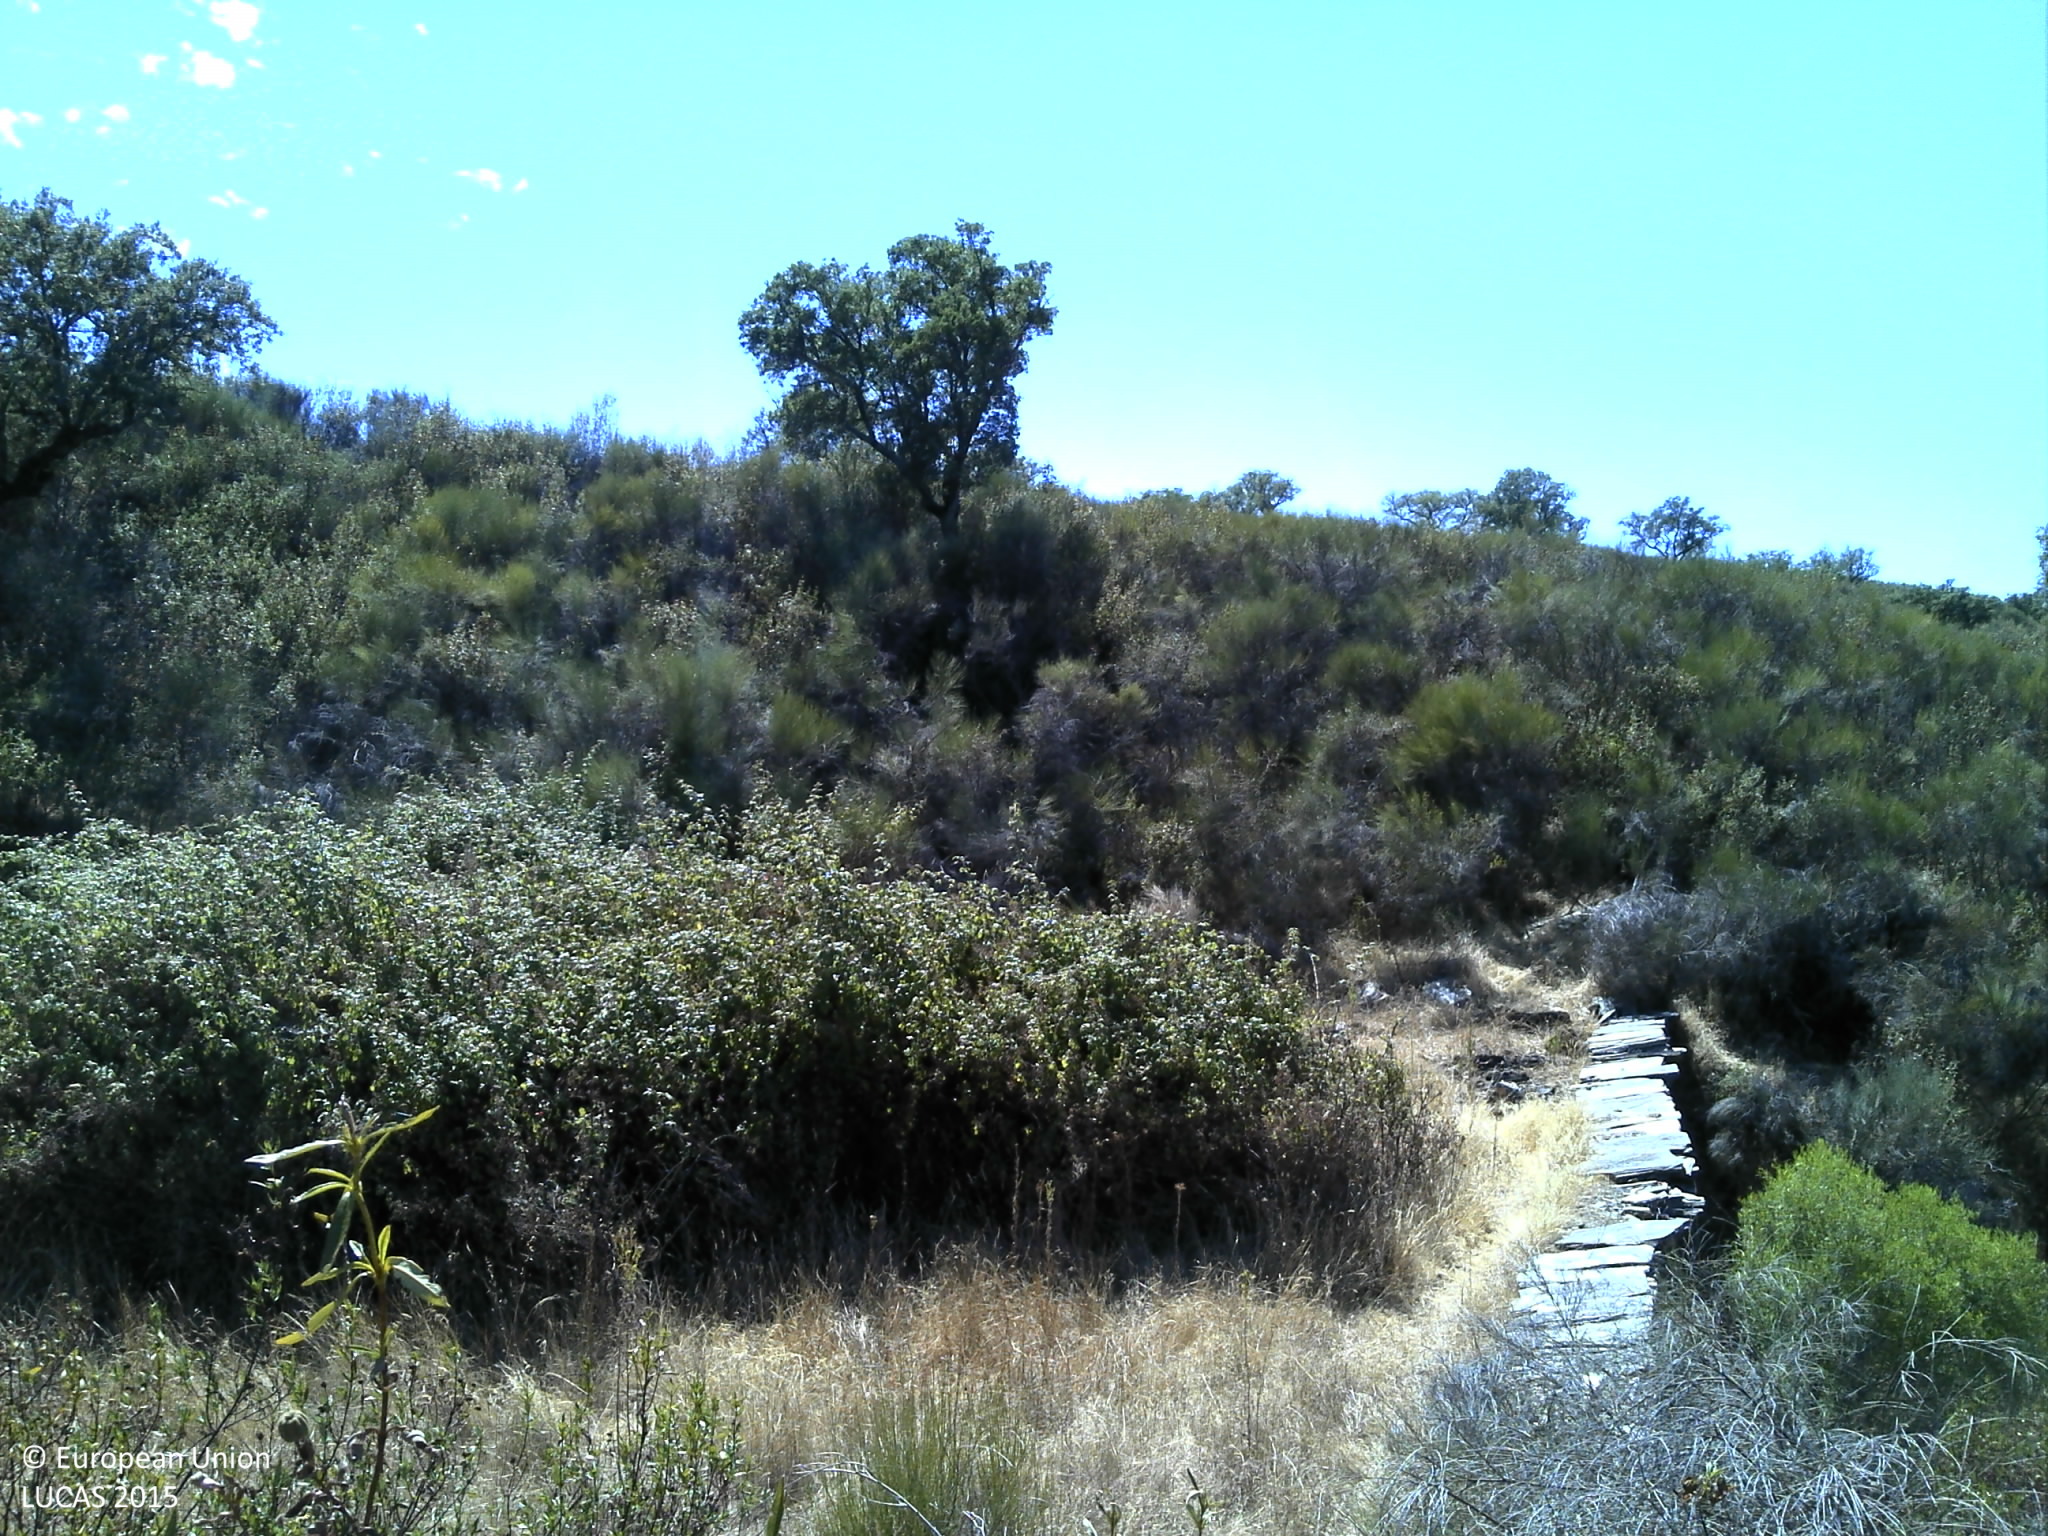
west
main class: Shrubland
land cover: Shrubland without tree cover
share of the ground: > 75 %
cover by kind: shrubs 95 %, unconsolidated bare surface 5 %
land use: Semi-natural and natural areas not in use
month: August
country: PT
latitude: 39.6118
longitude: -7.5565
